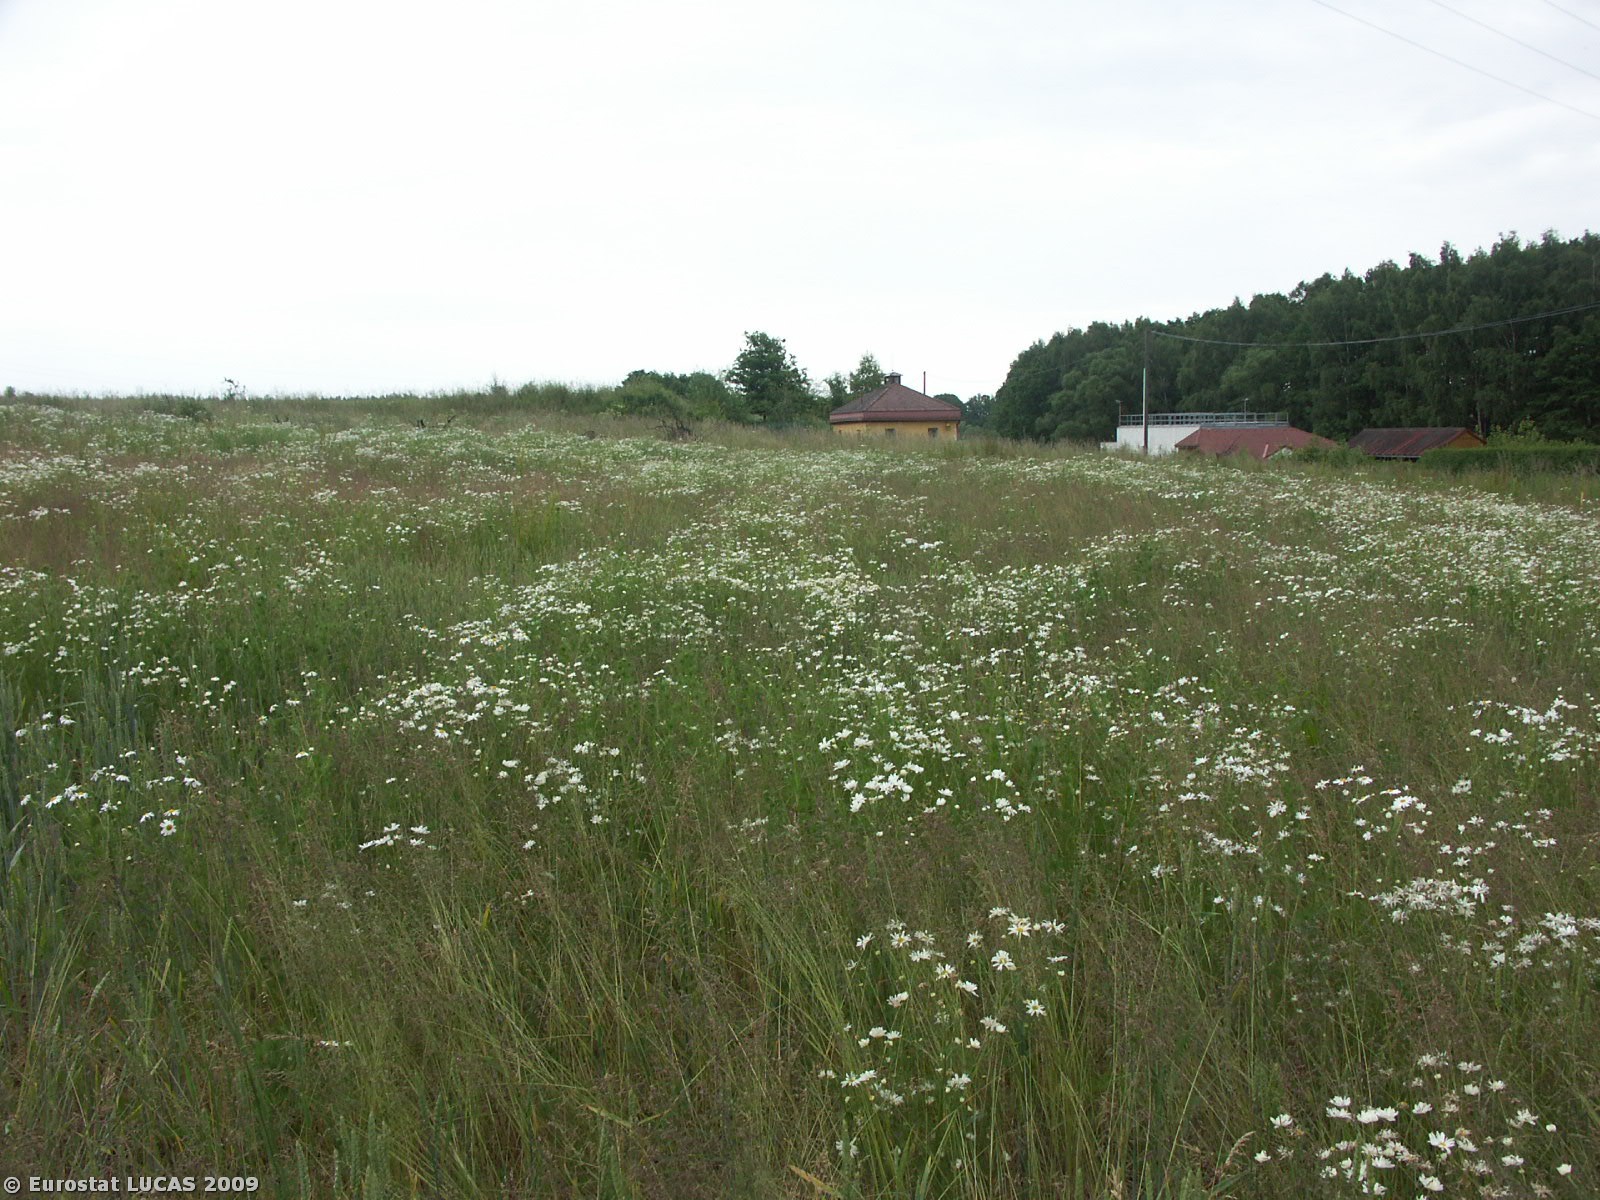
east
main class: Grassland
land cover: Spontaneously vegetated surfaces
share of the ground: > 75 %
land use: Fallow land
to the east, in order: Spontaneously vegetated surfaces; Electric lines; Spontaneously vegetated surfaces; Grassland without tree/shrub cover; Artificial constructions in urban areas; Grassland with sparse tree/shrub cover; Paved roads, cycling and walking lanes; Electric lines; Grassland with sparse tree/shrub cover; Inland water bodies
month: June
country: CZ
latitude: 48.9373
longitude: 14.6292
